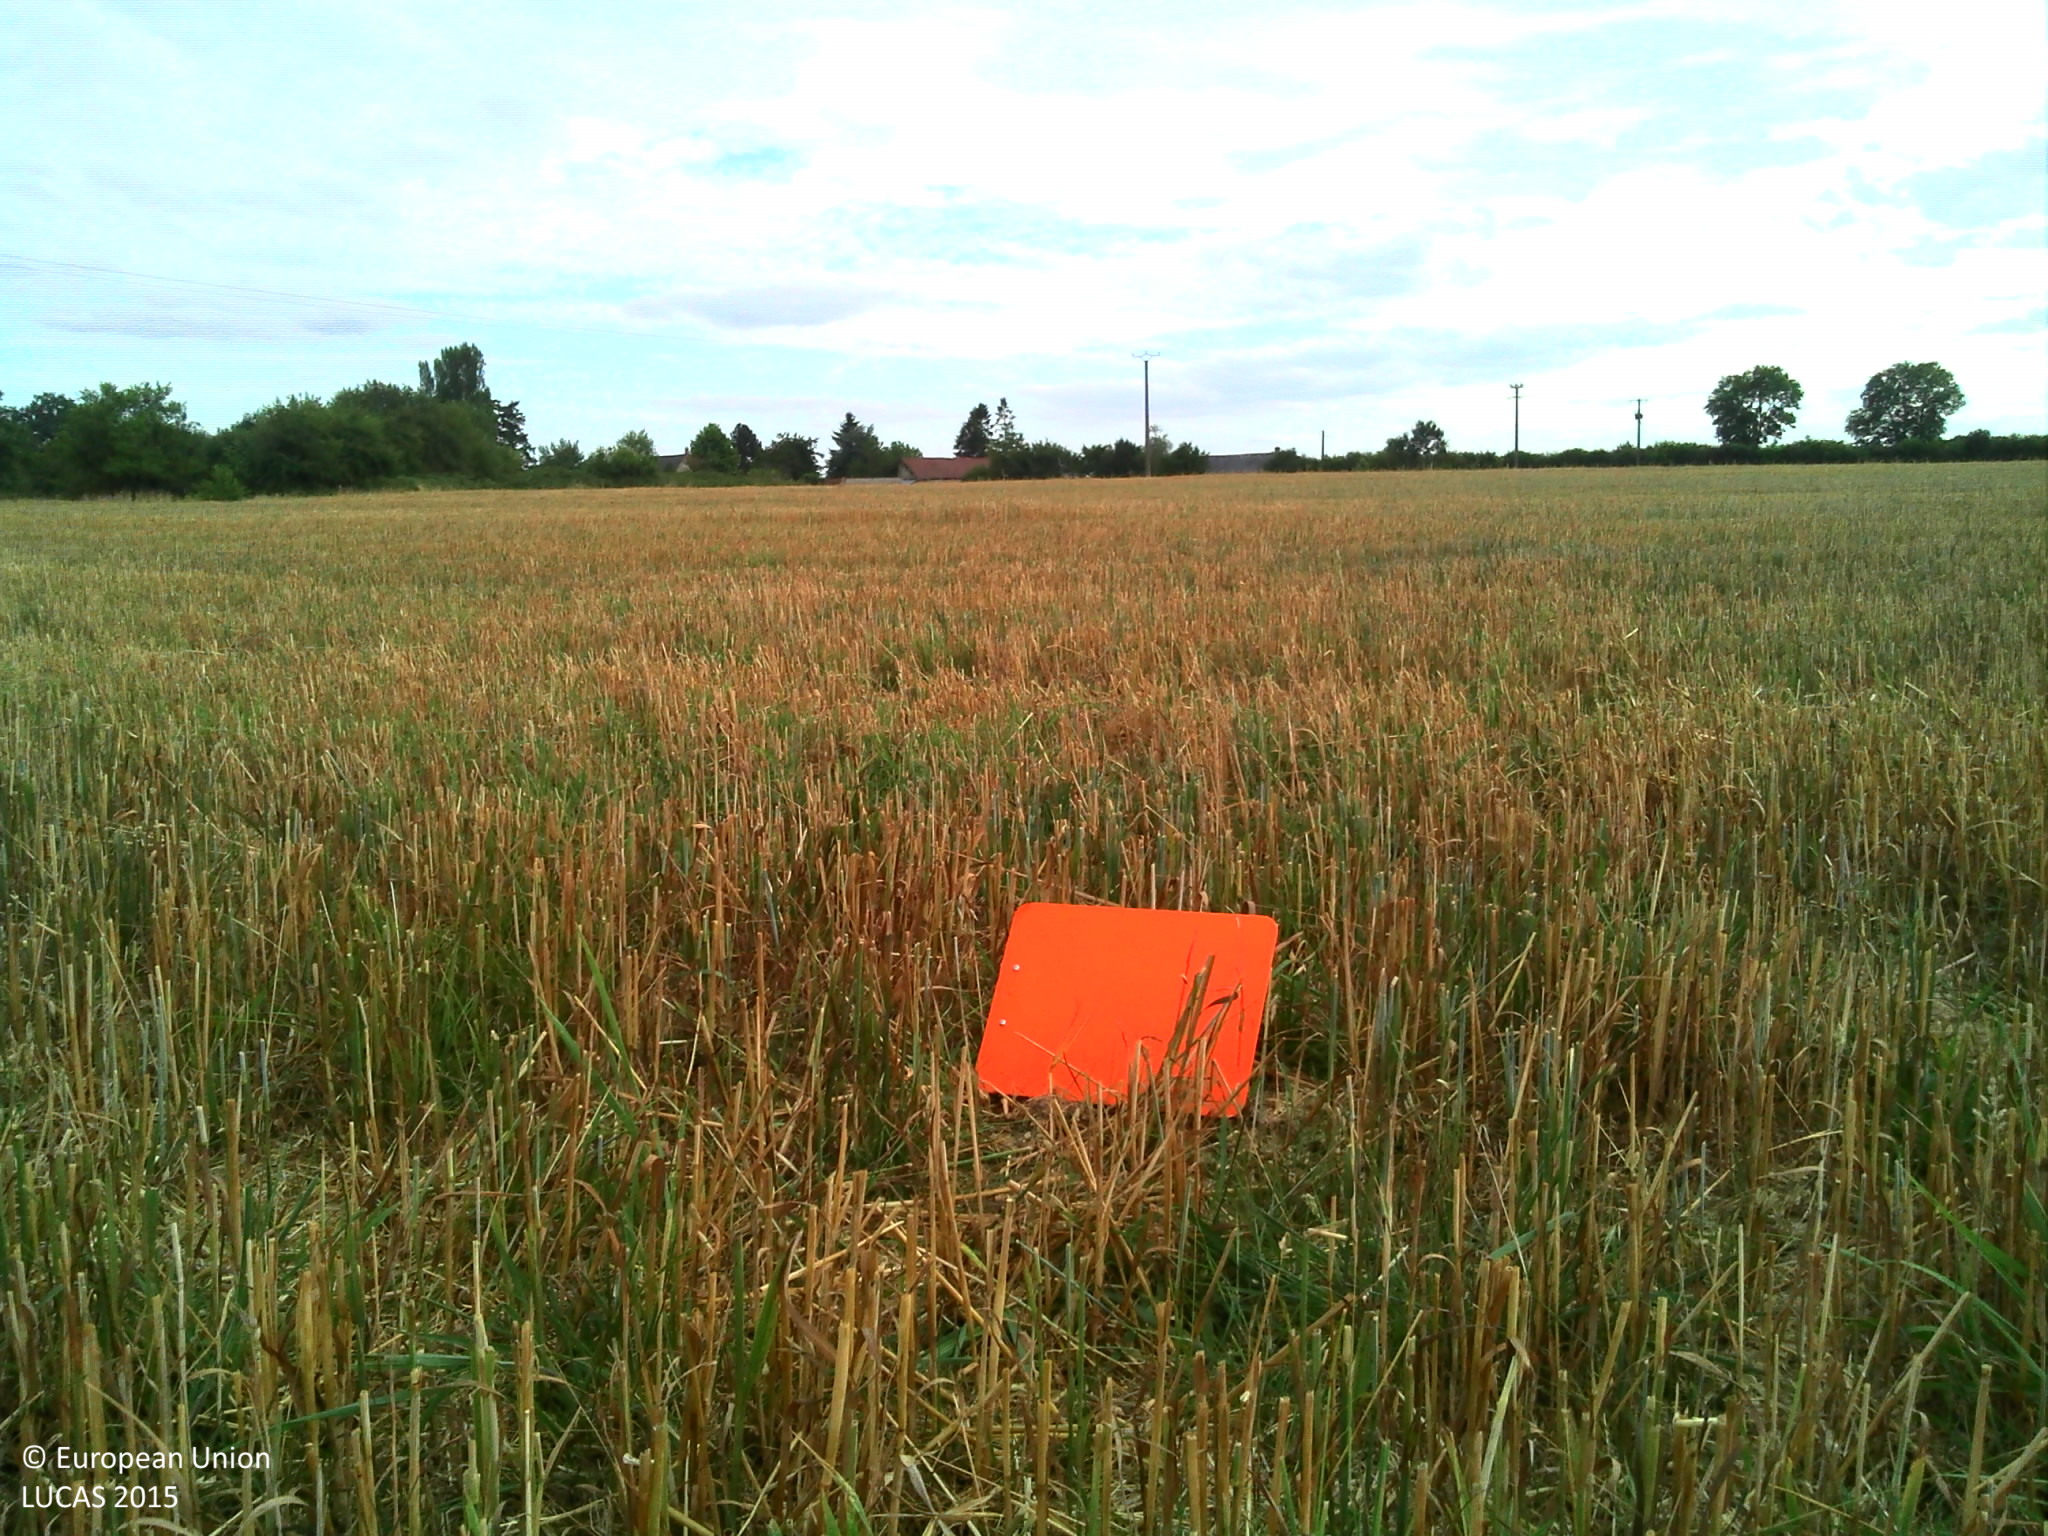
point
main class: Cropland
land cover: Oats
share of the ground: > 75 %
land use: Agriculture (excluding fallow land and kitchen gardens)
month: July
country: FR
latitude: 48.6958
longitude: 0.4504
